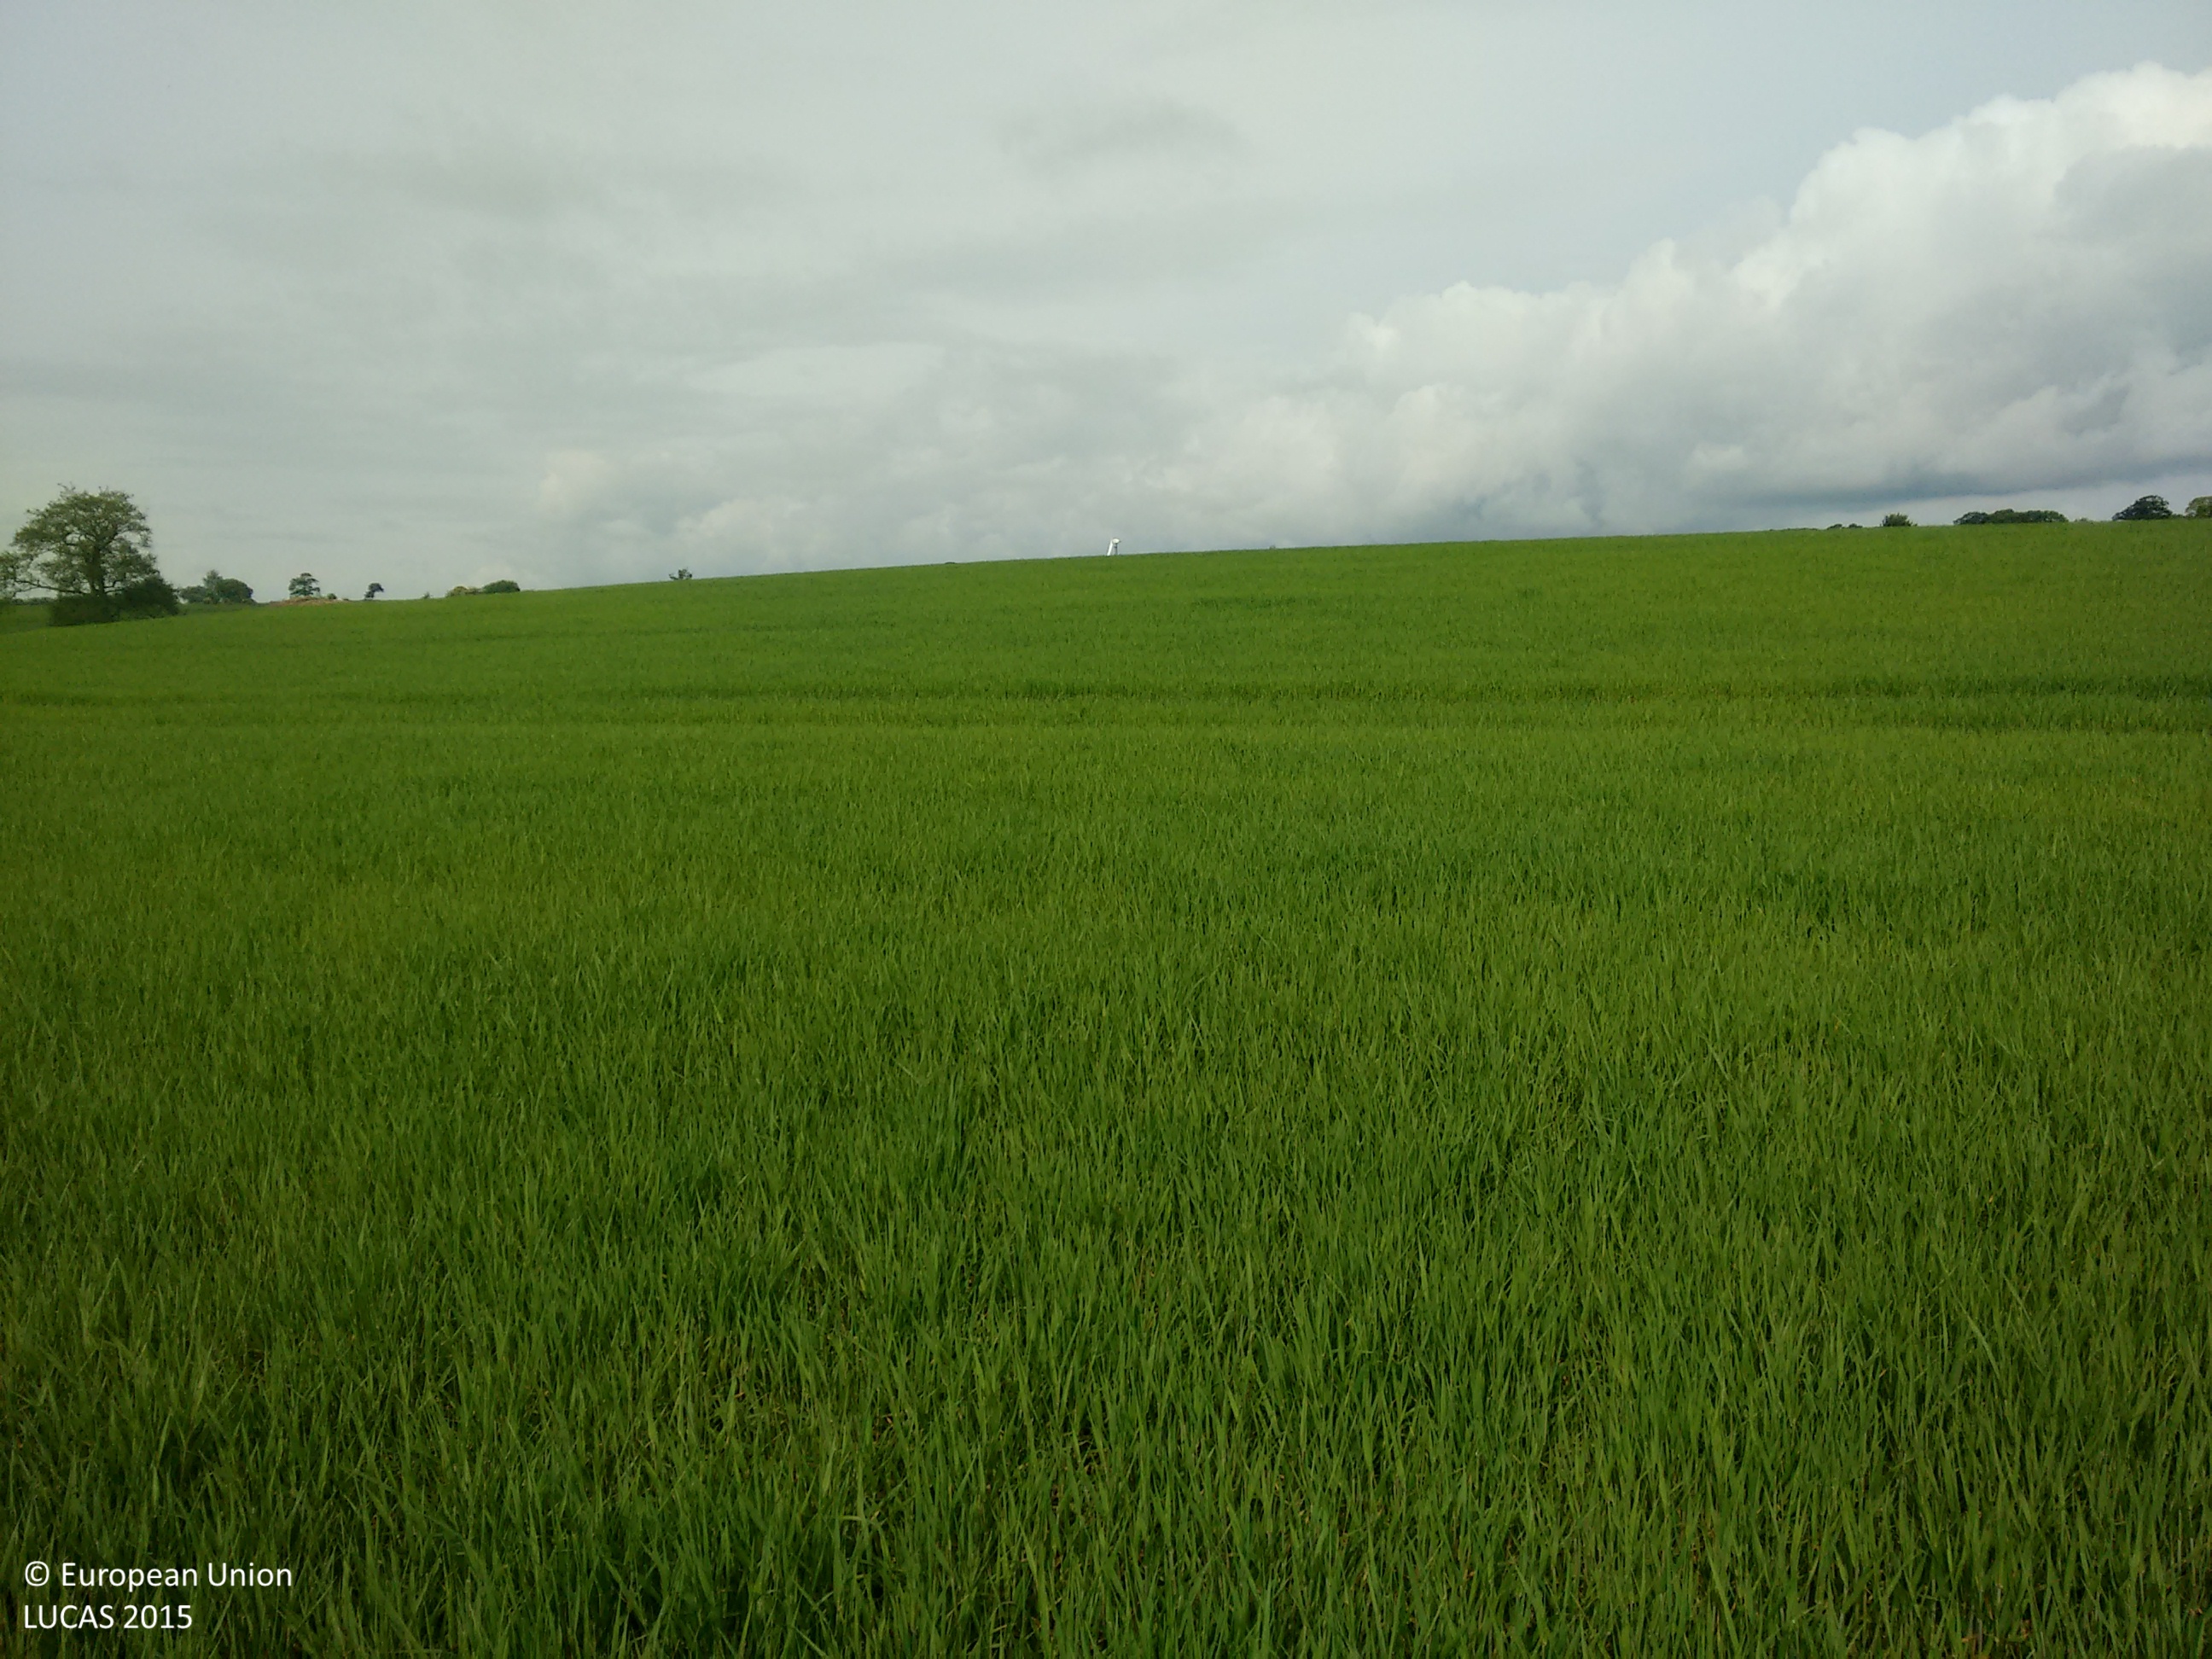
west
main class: Cropland
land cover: Barley
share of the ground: > 75 %
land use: Agriculture (excluding fallow land and kitchen gardens)
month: June
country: GB
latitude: 56.2520
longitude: -3.3566
